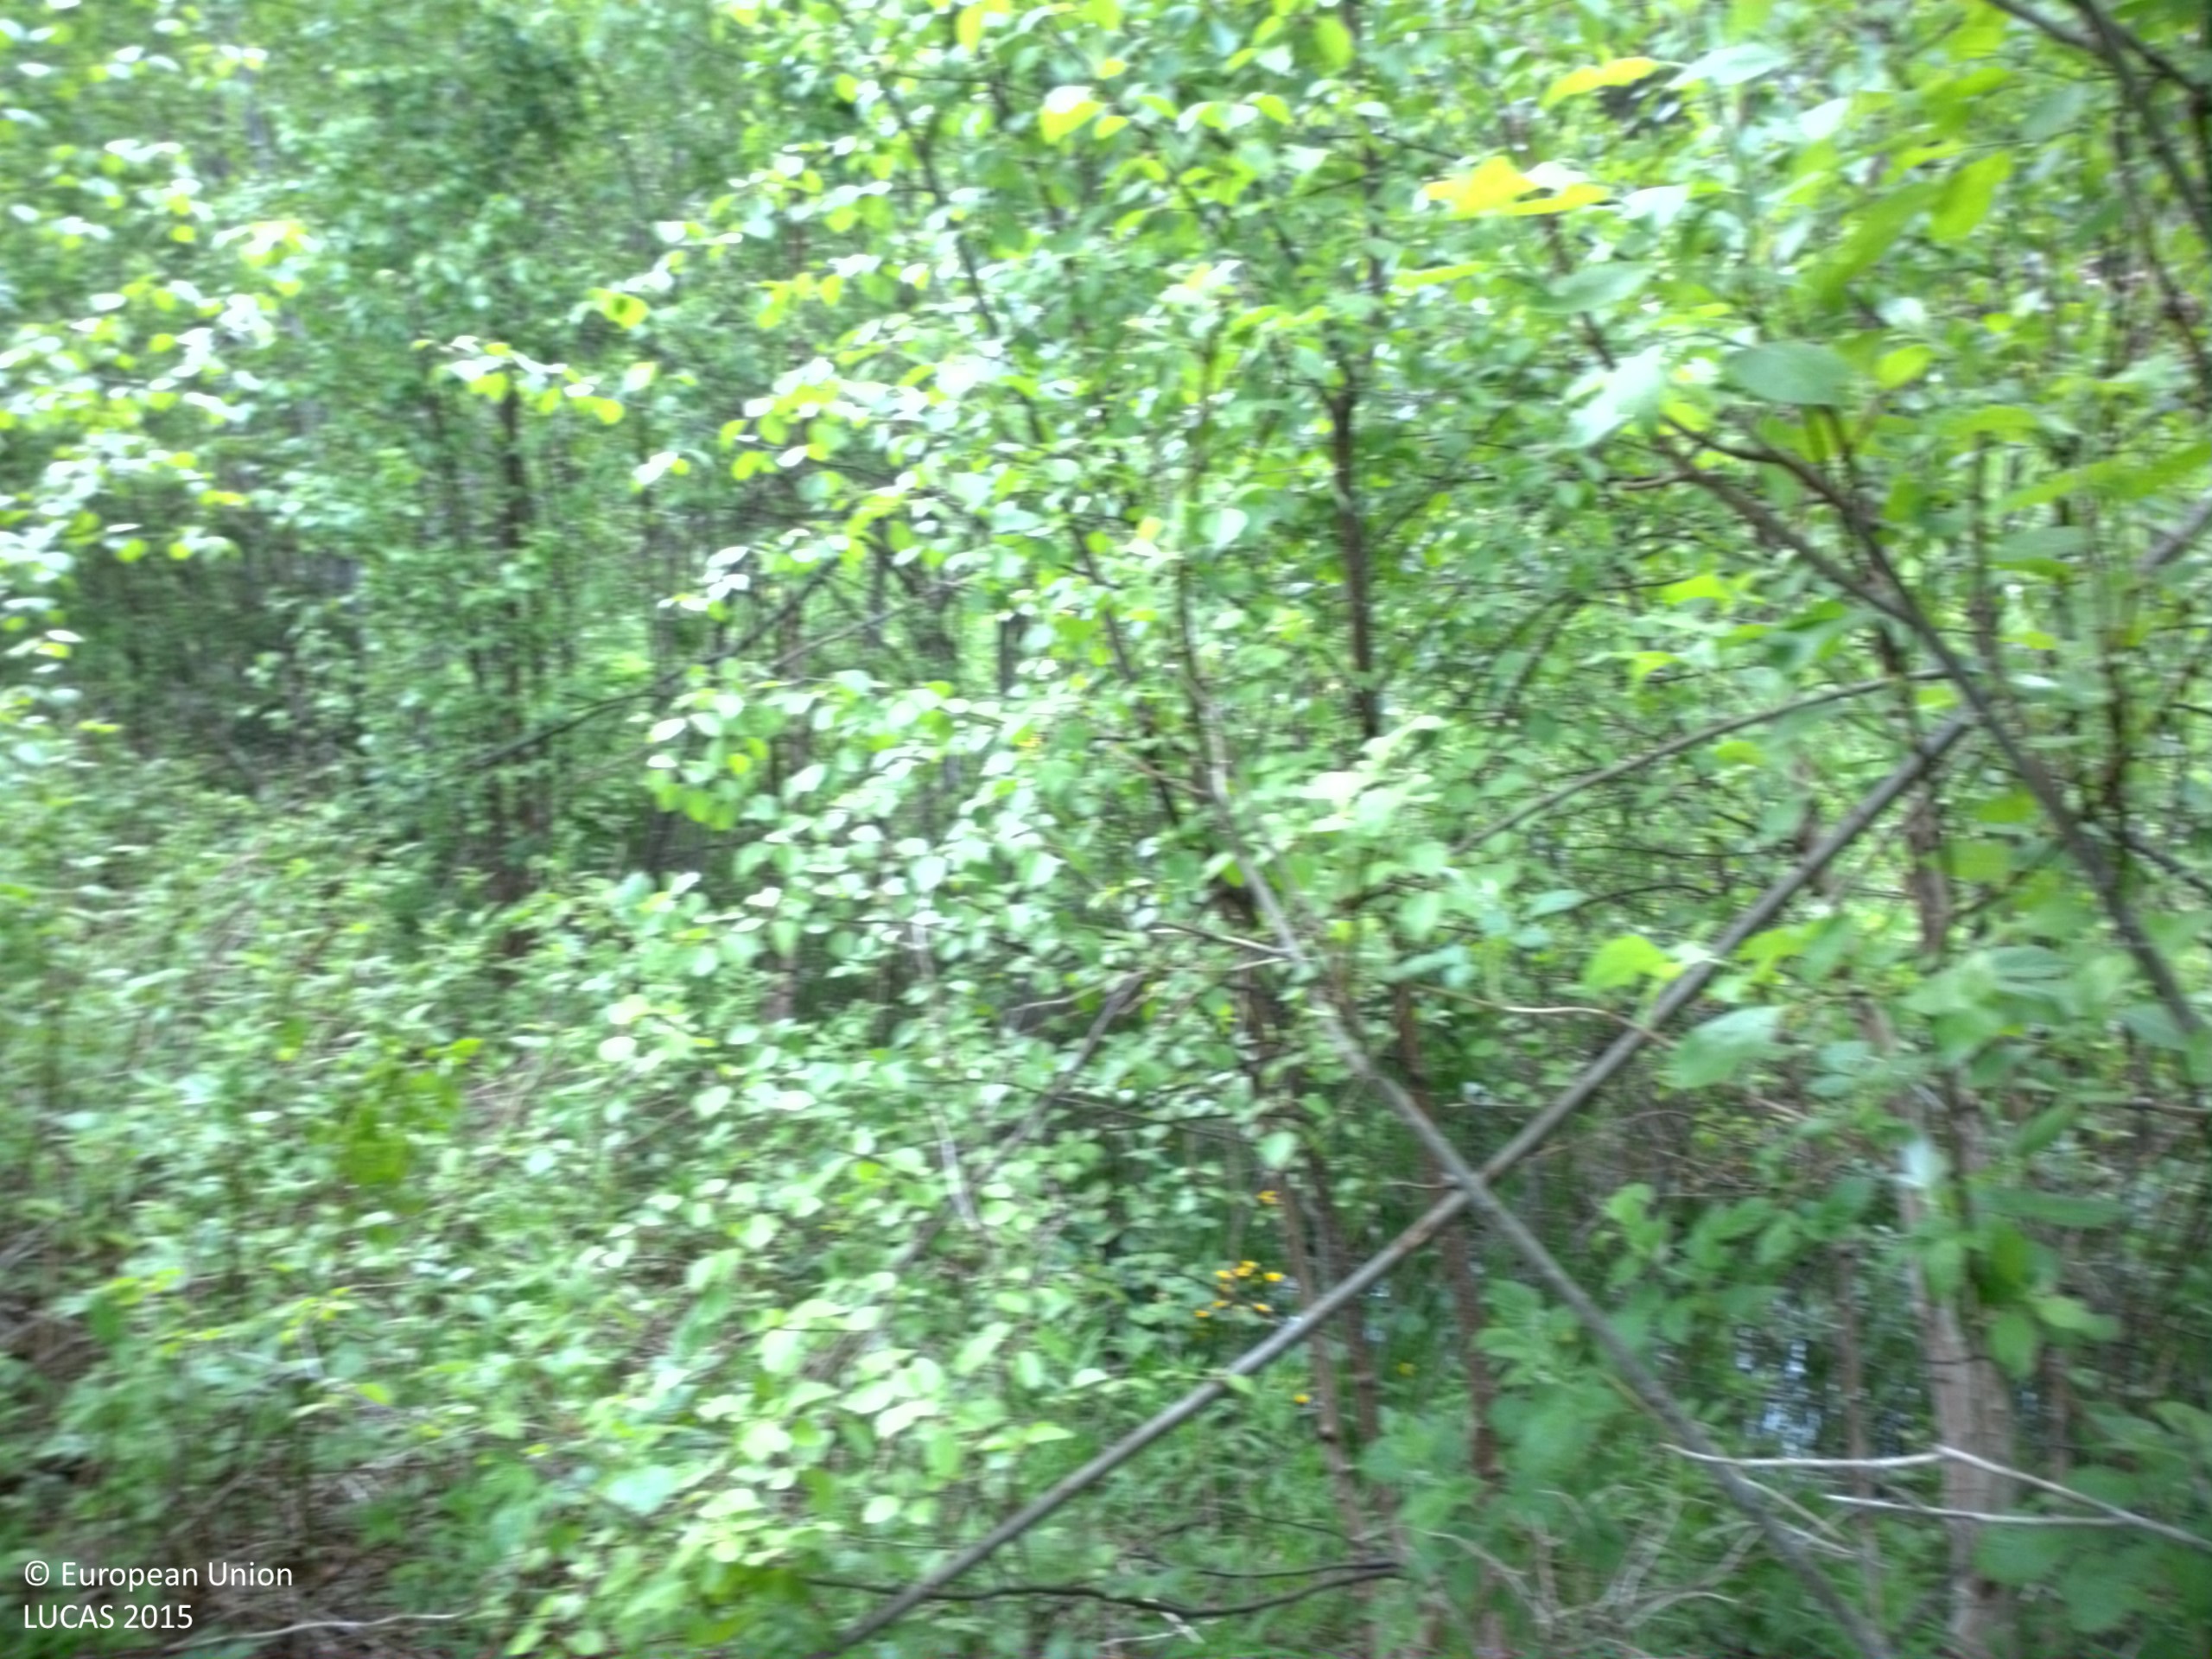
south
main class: Woodland
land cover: Broadleaved woodland
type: hemiboreal forest and nemoral coniferous forest and mixed broadleaved-coniferous forest
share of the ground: > 75 %
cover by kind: broadleaved forest trees 85 %, herbaceous plants 15 %
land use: Forestry
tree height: < 5 m
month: June
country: SE
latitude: 62.9637
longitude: 17.9645
